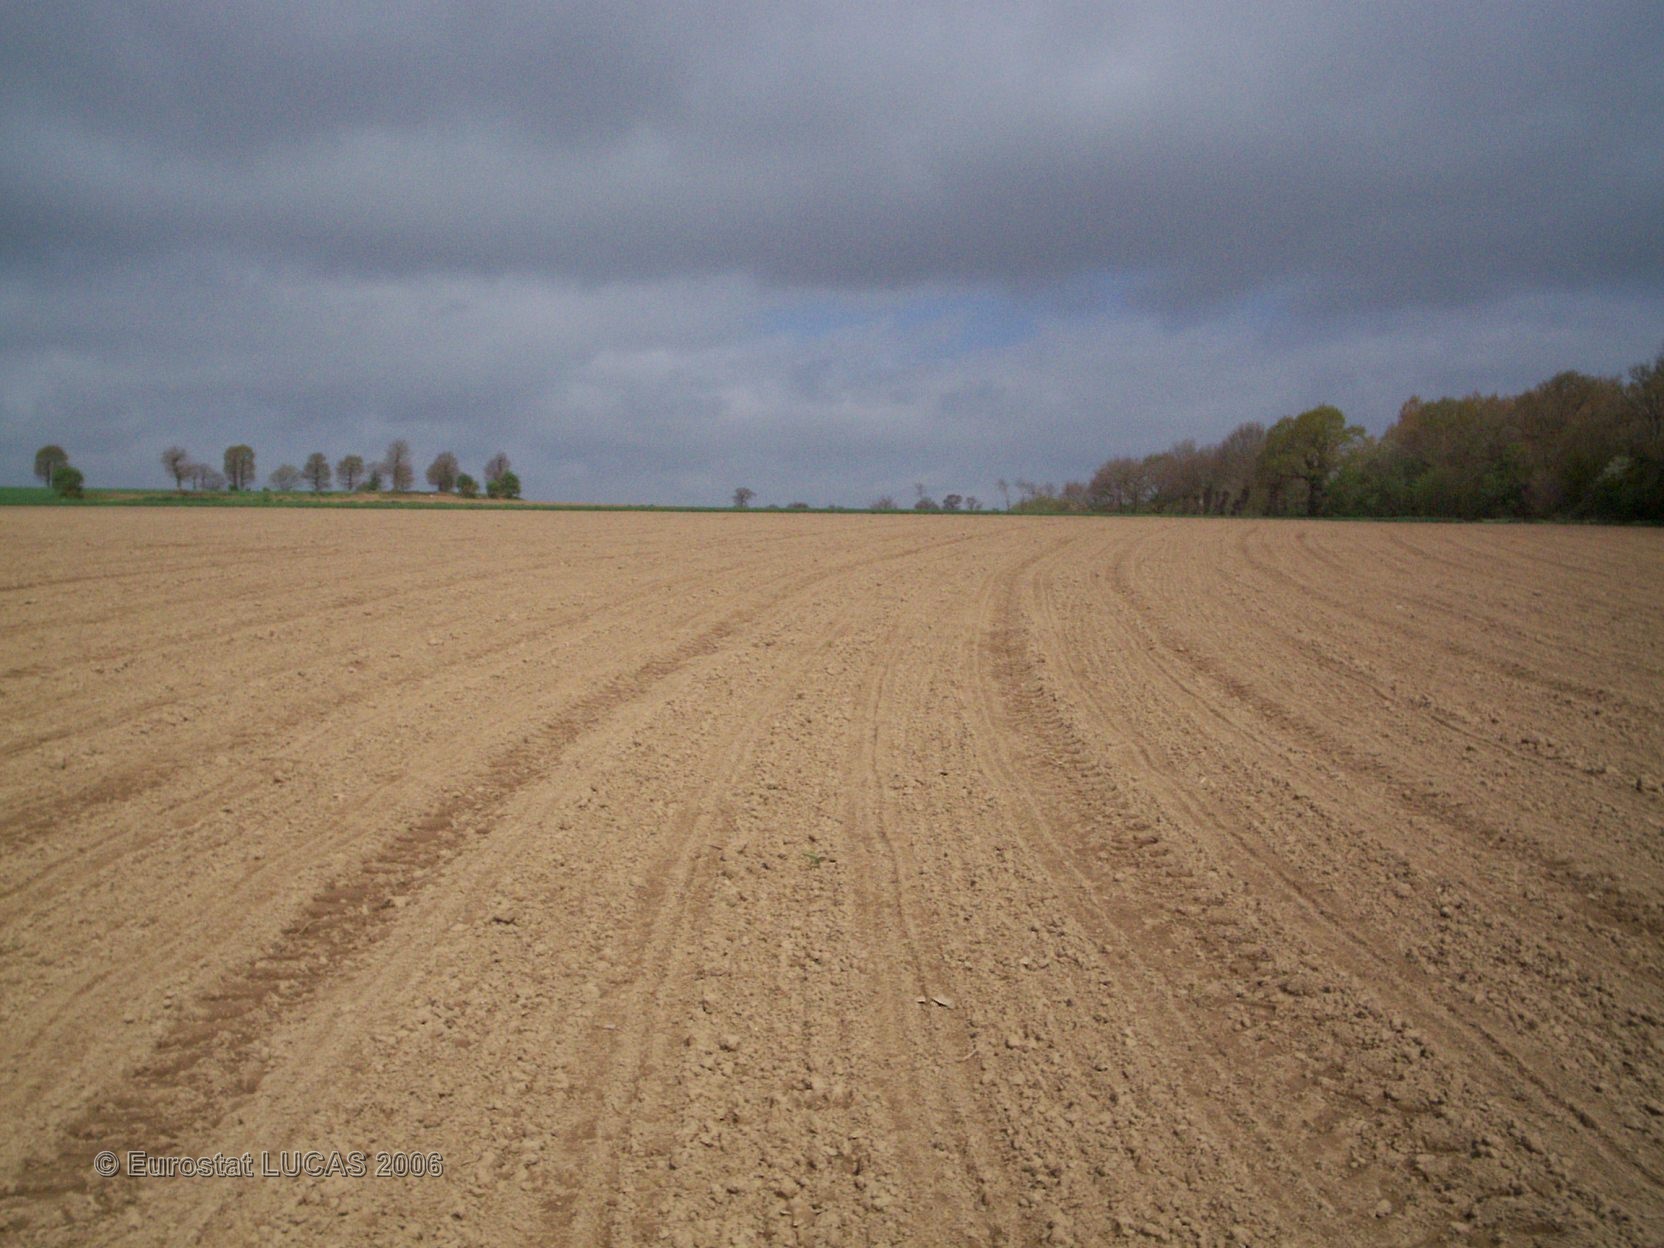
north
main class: Cropland
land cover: Maize
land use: Agriculture (excluding fallow land and kitchen gardens)
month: June
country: FR
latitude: 48.3683
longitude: -2.4660
